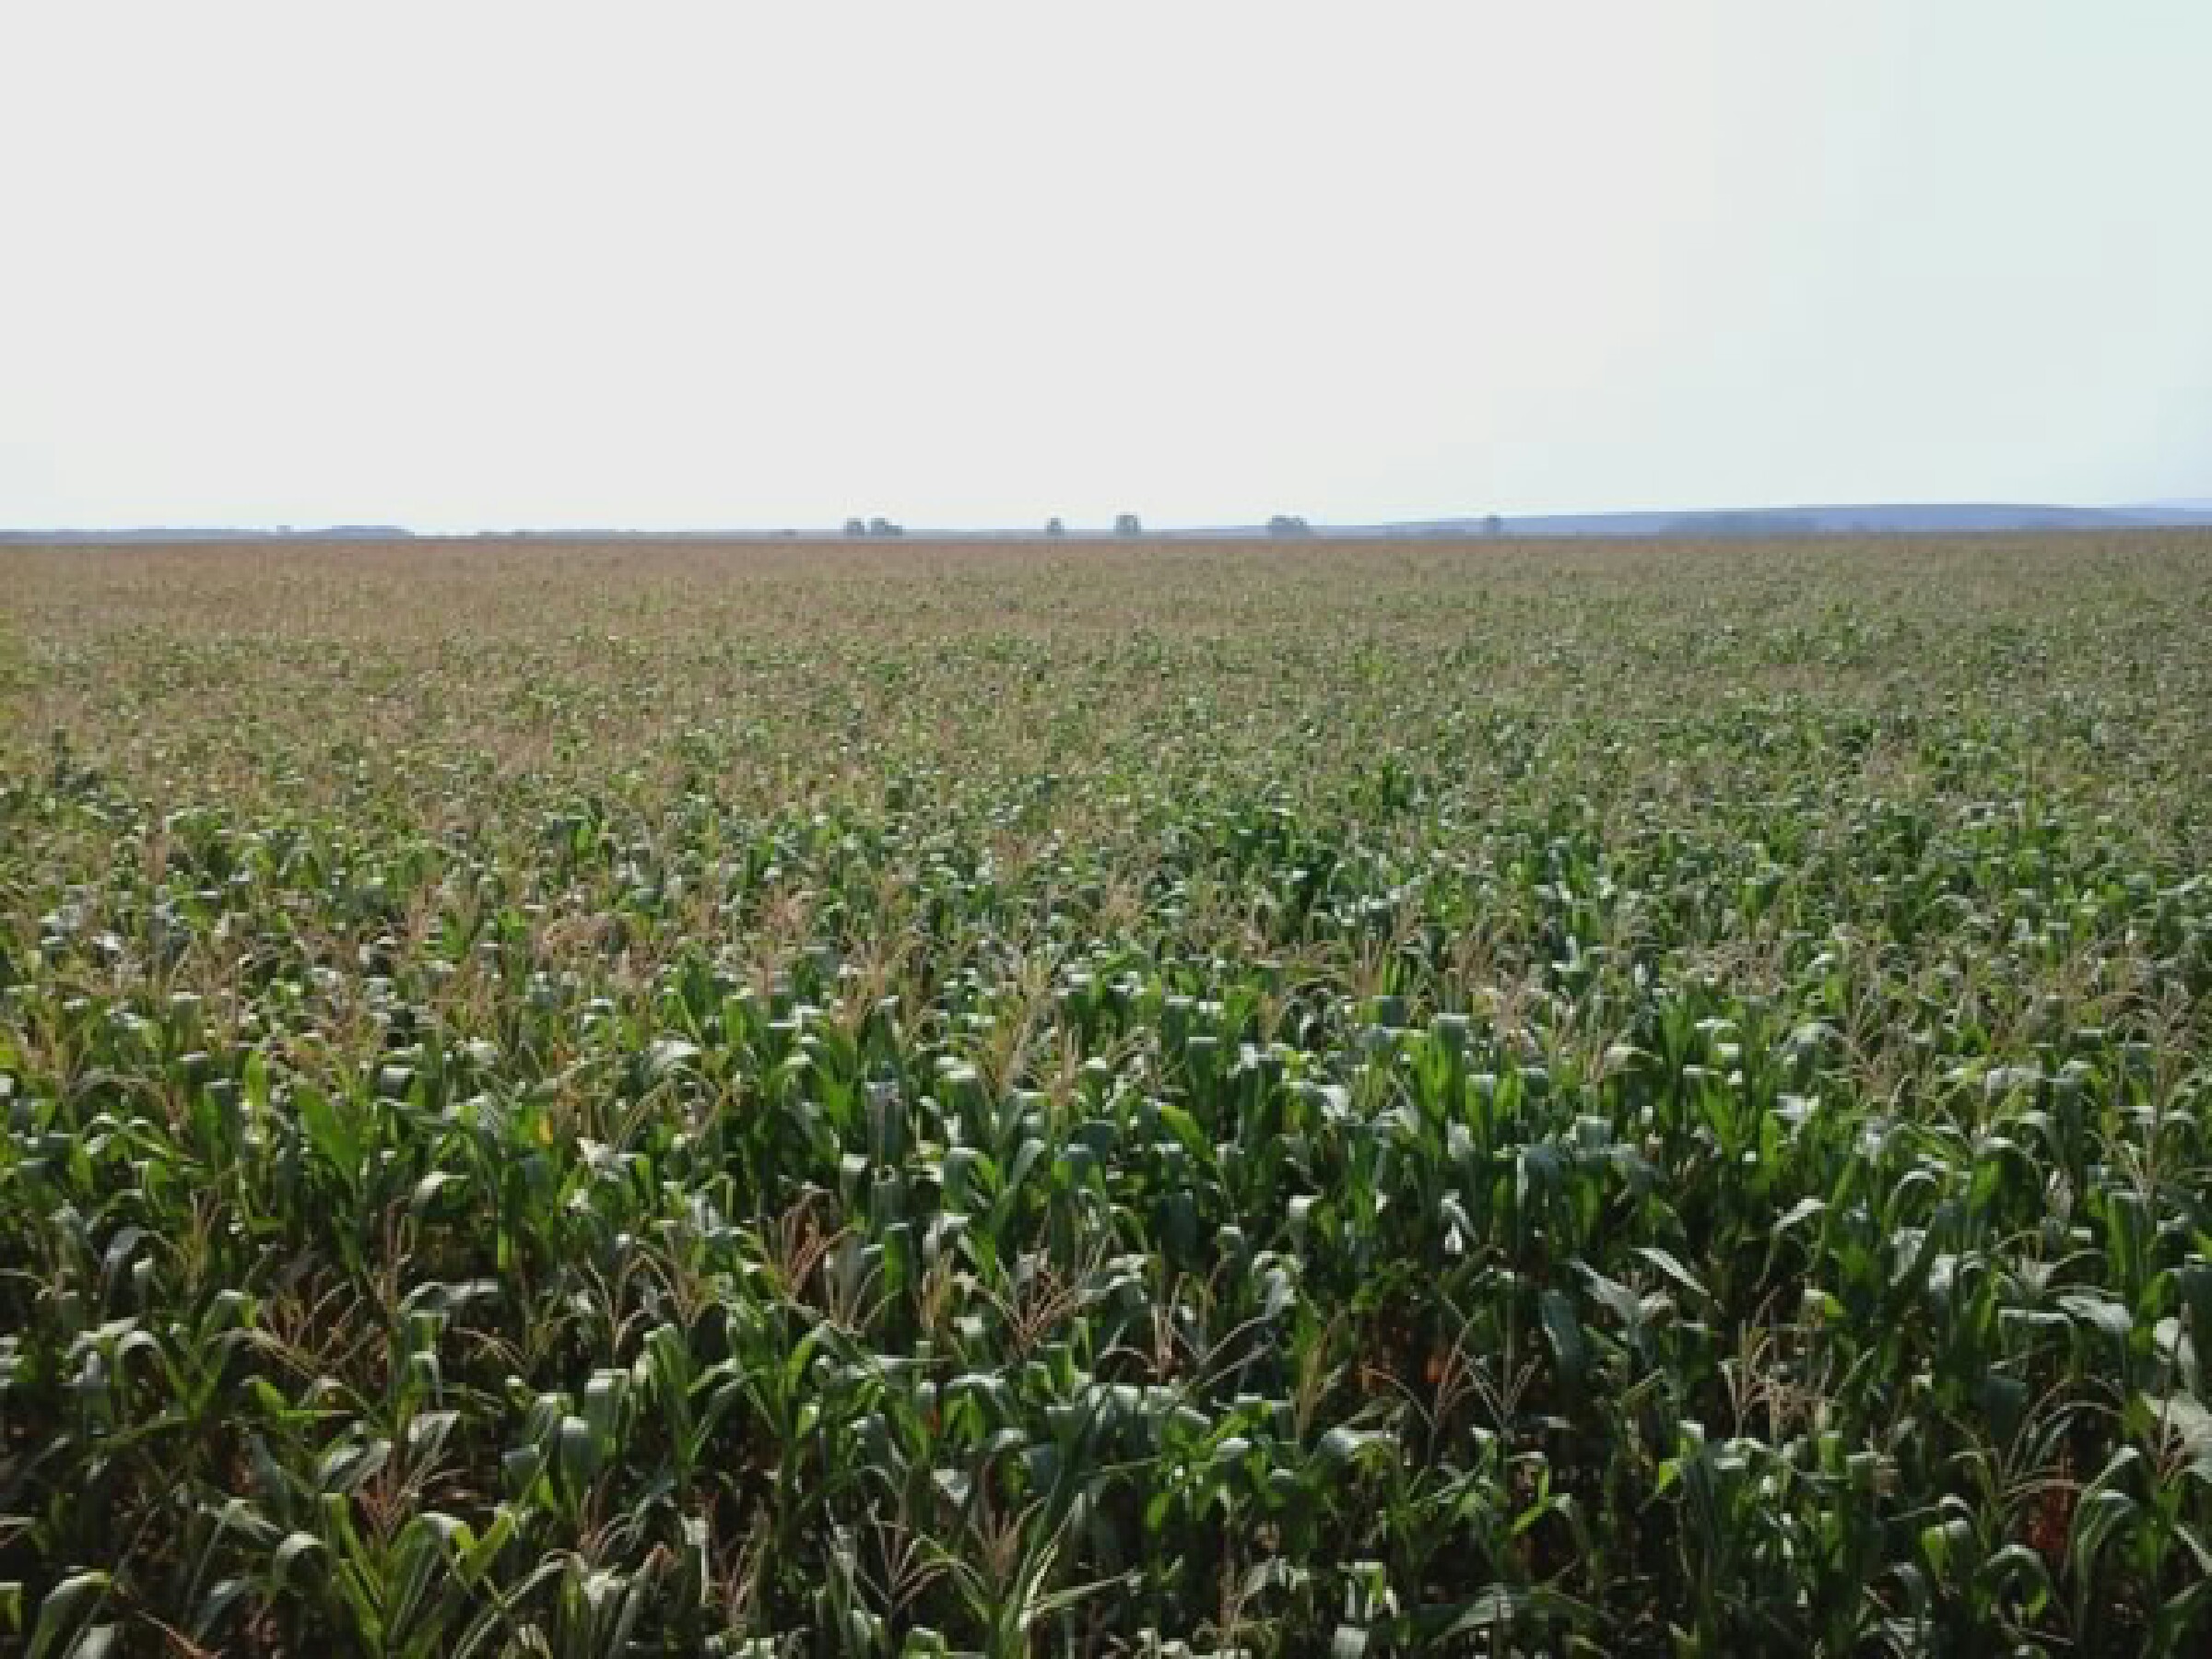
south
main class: Cropland
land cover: Maize
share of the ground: > 75 %
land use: Agriculture (excluding fallow land and kitchen gardens)
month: August
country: HU
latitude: 48.0255
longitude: 19.1251
